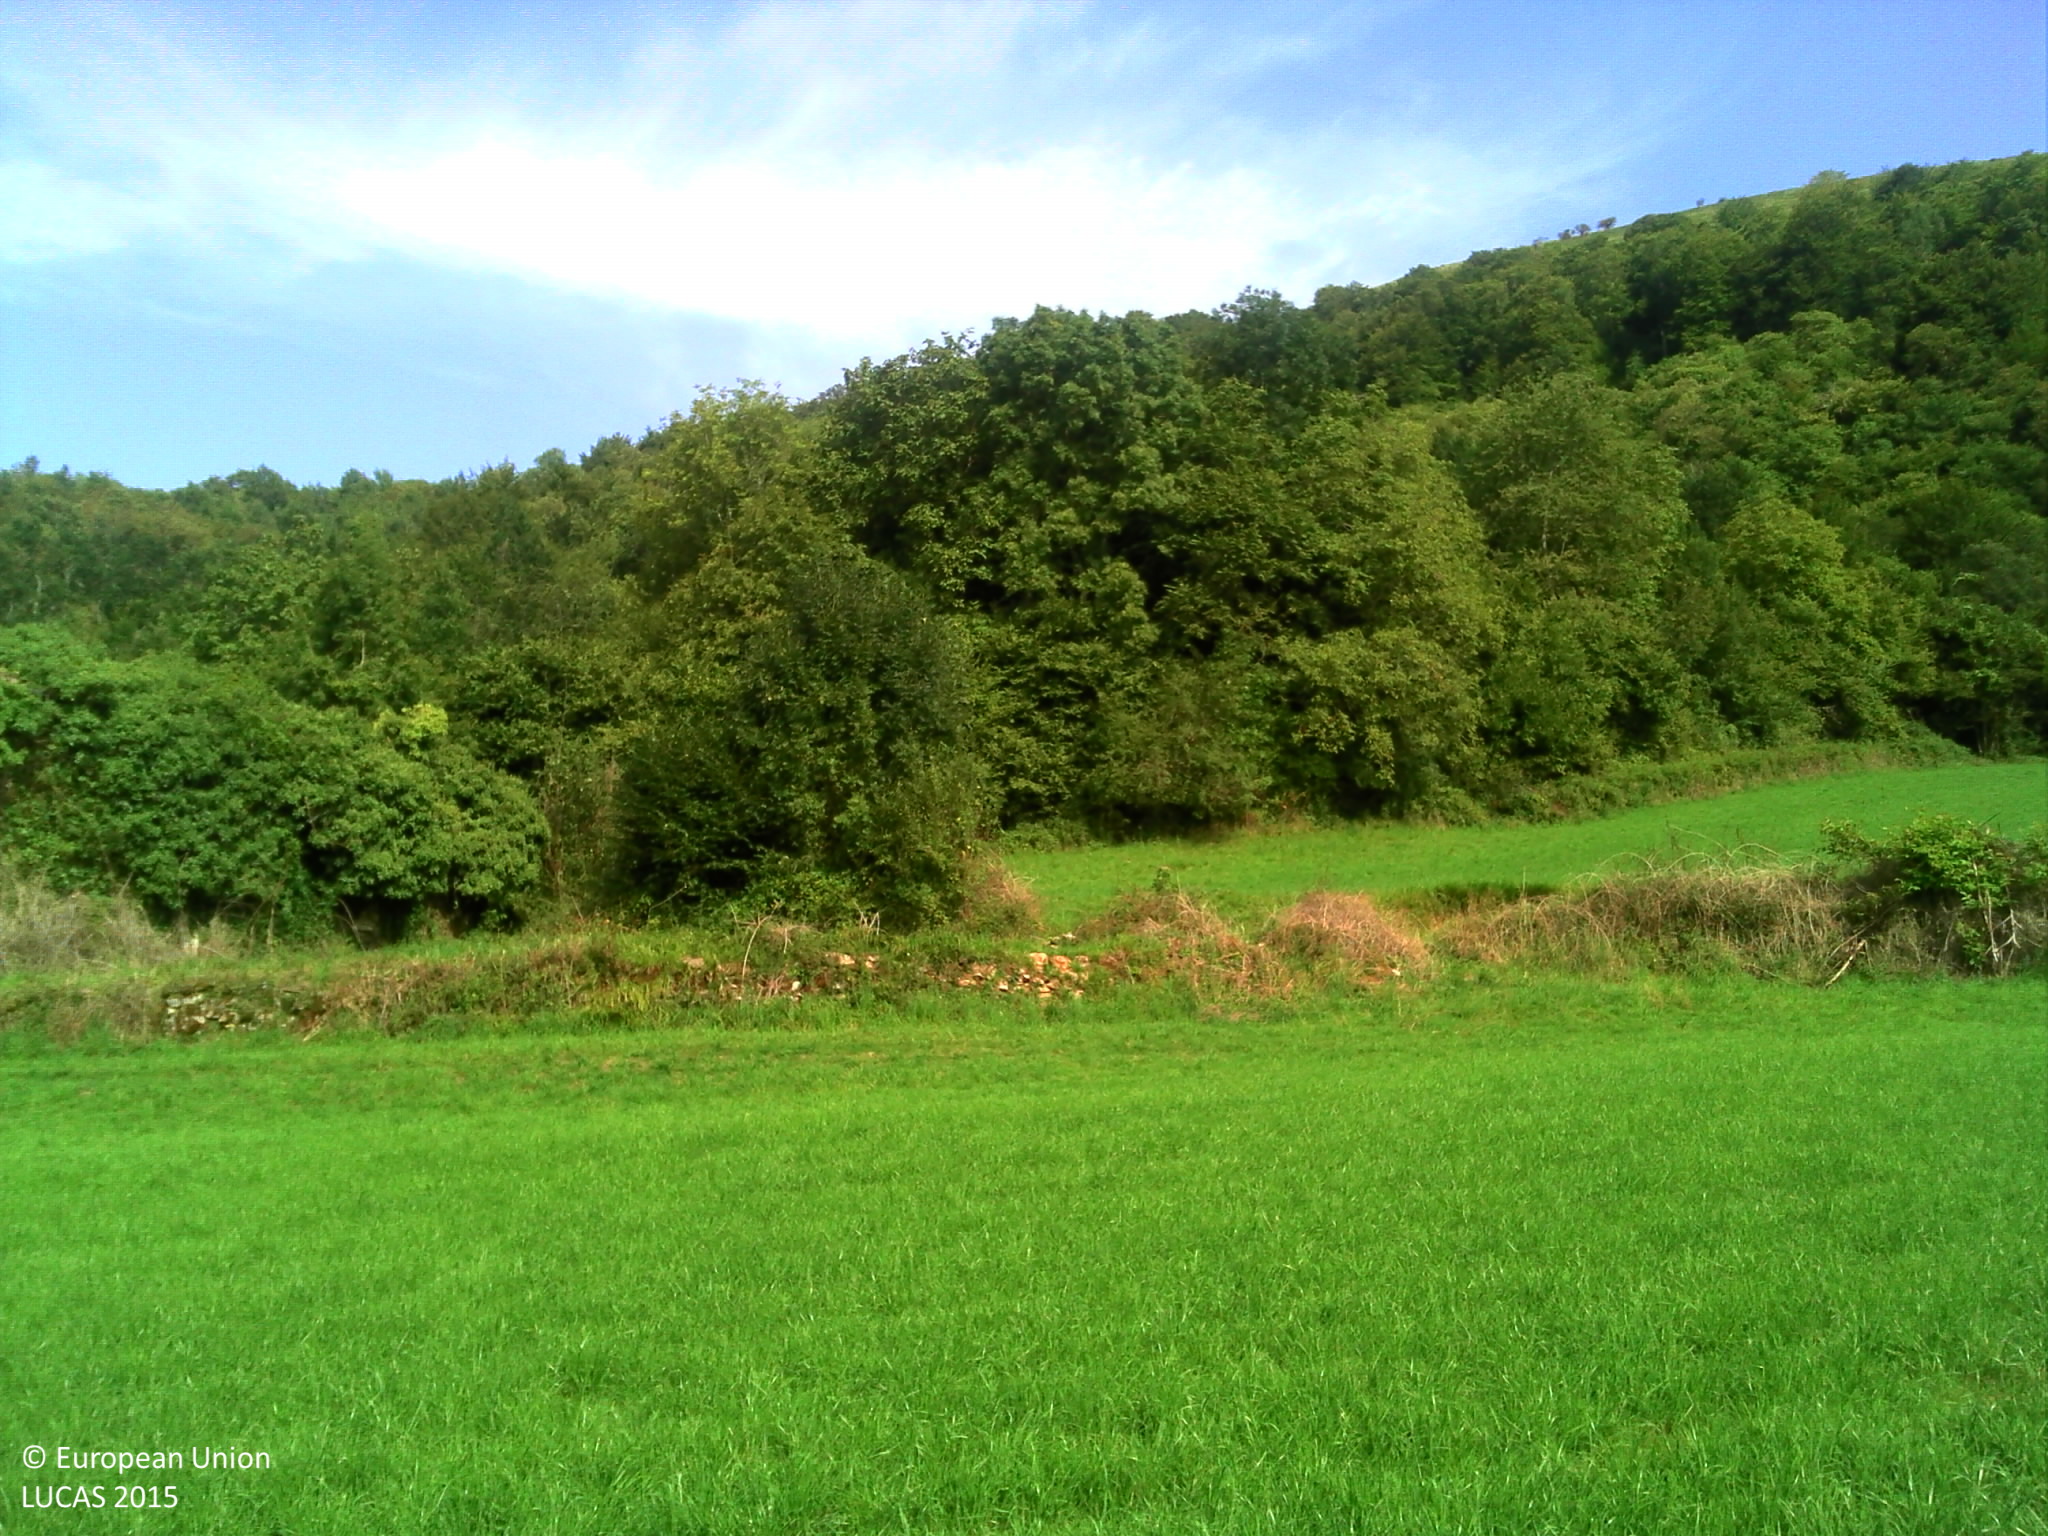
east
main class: Cropland
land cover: Temporary grasslands
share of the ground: > 75 %
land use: Agriculture (excluding fallow land and kitchen gardens)
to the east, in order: Temporary grasslands; Dry stone walls; Grassland without tree/shrub cover; Shruby margins; Temporary grasslands; Broadleaved woodland; Dry stone walls; Tracks; Broadleaved woodland; Tracks; Broadleaved woodland; Tracks; Broadleaved woodland
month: September
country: FR
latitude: 43.1562
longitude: -1.0675
